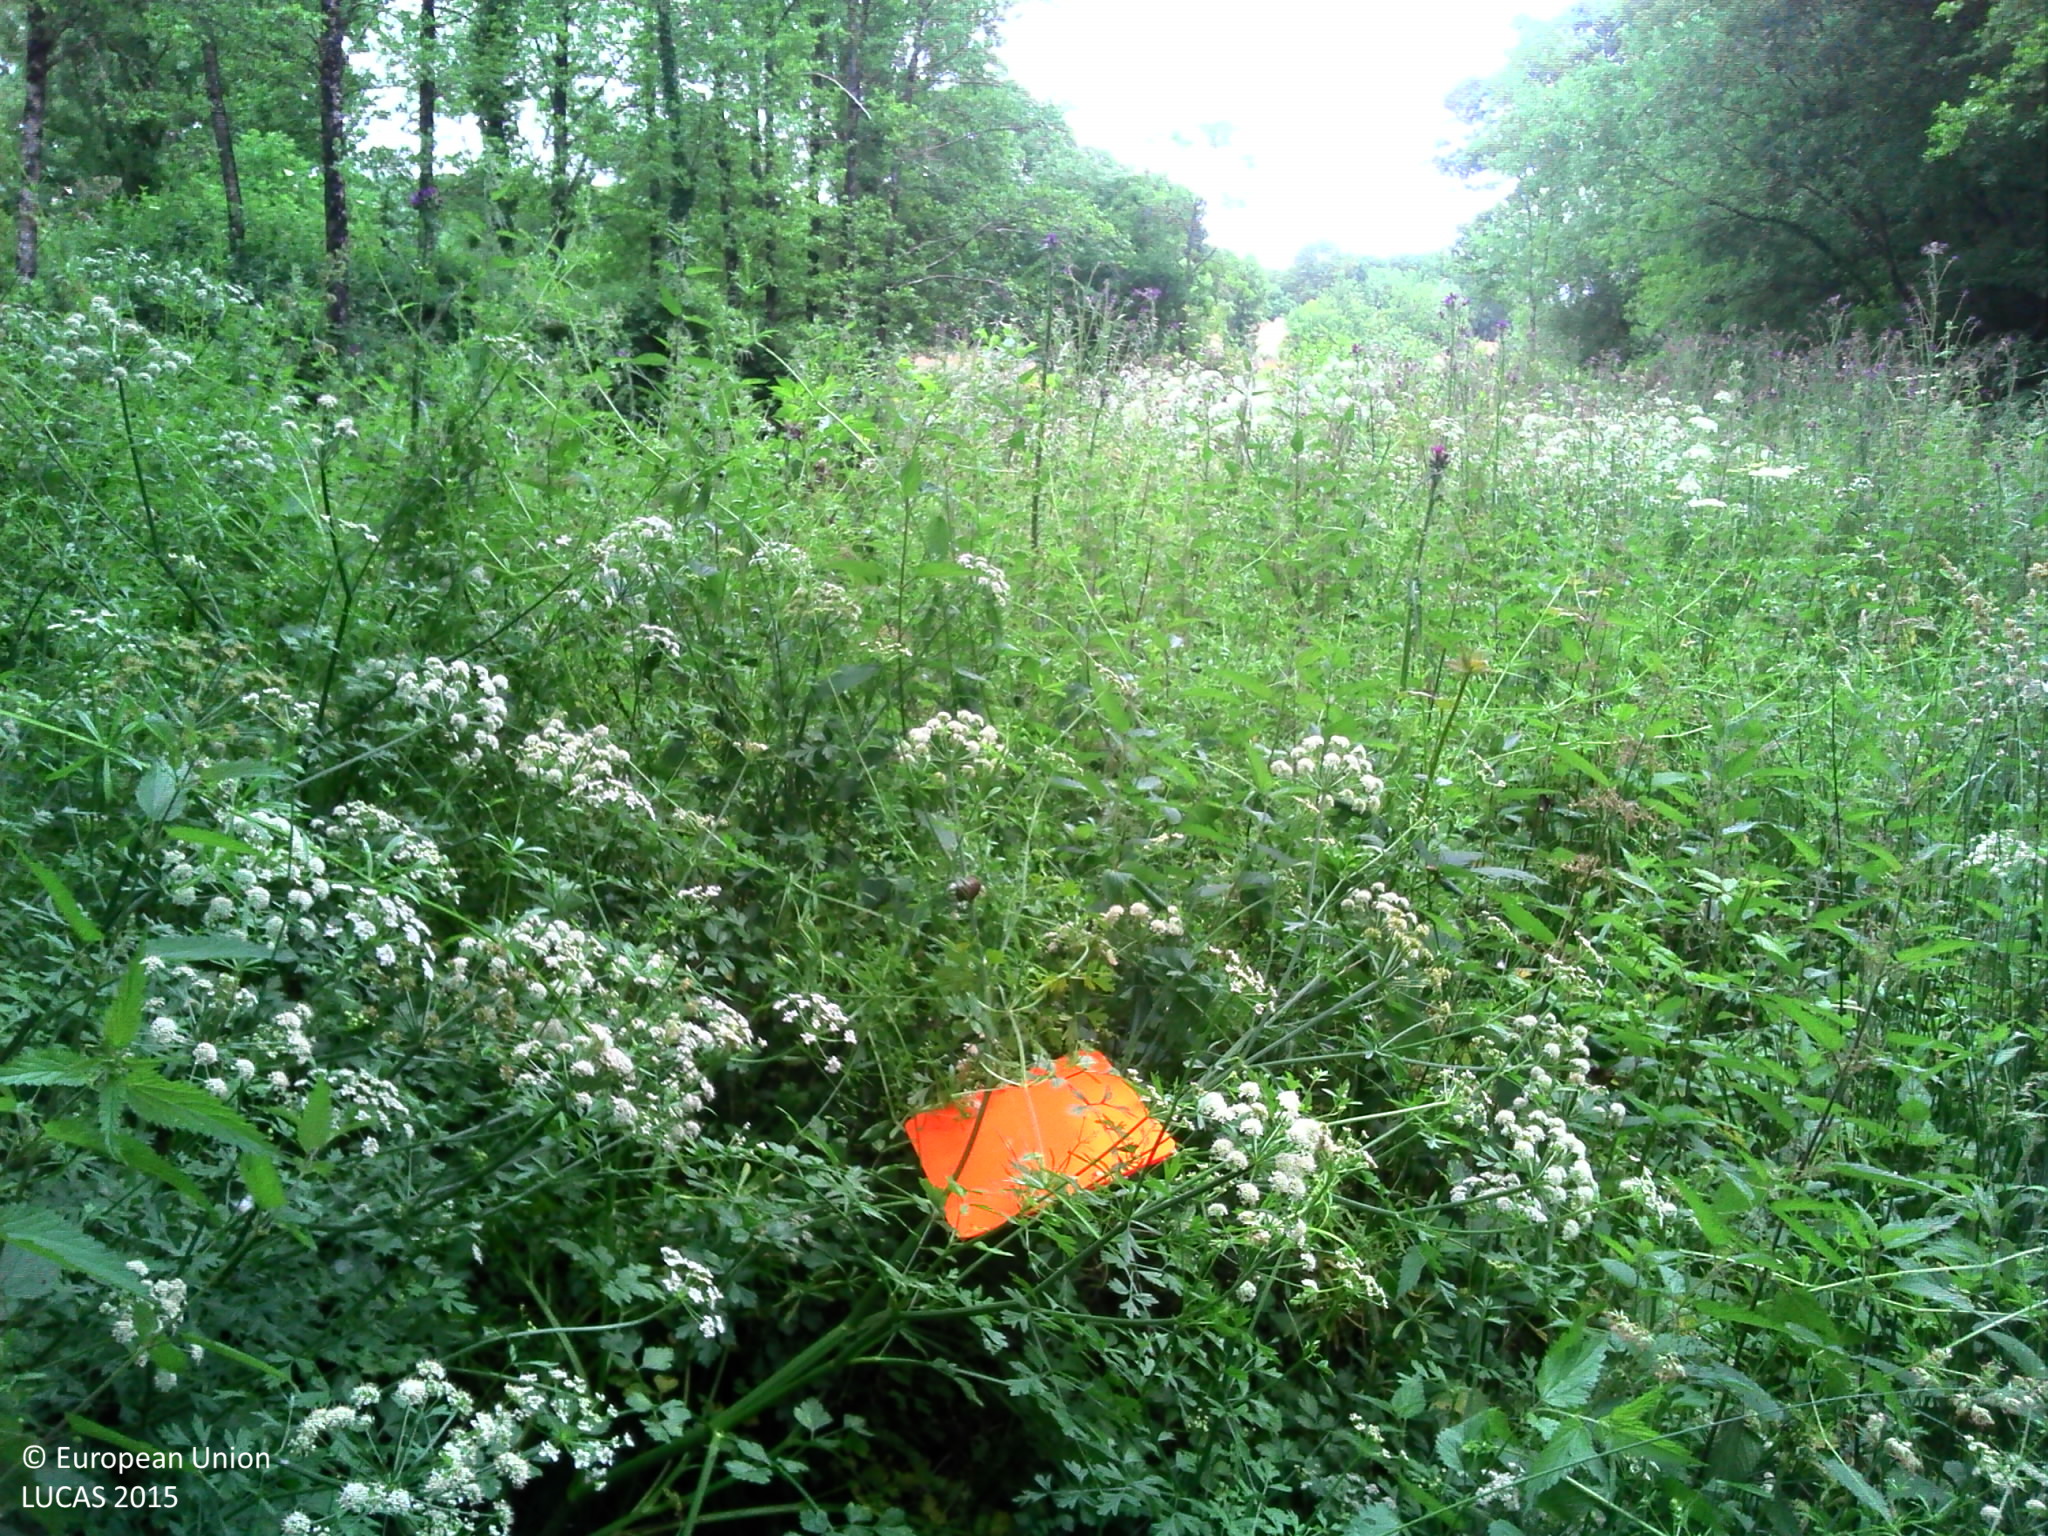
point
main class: Grassland
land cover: Spontaneously vegetated surfaces
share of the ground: > 75 %
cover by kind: herbaceous plants 95 %, shrubs 5 %
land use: Semi-natural and natural areas not in use
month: June
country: FR
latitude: 46.8382
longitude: -1.8313
